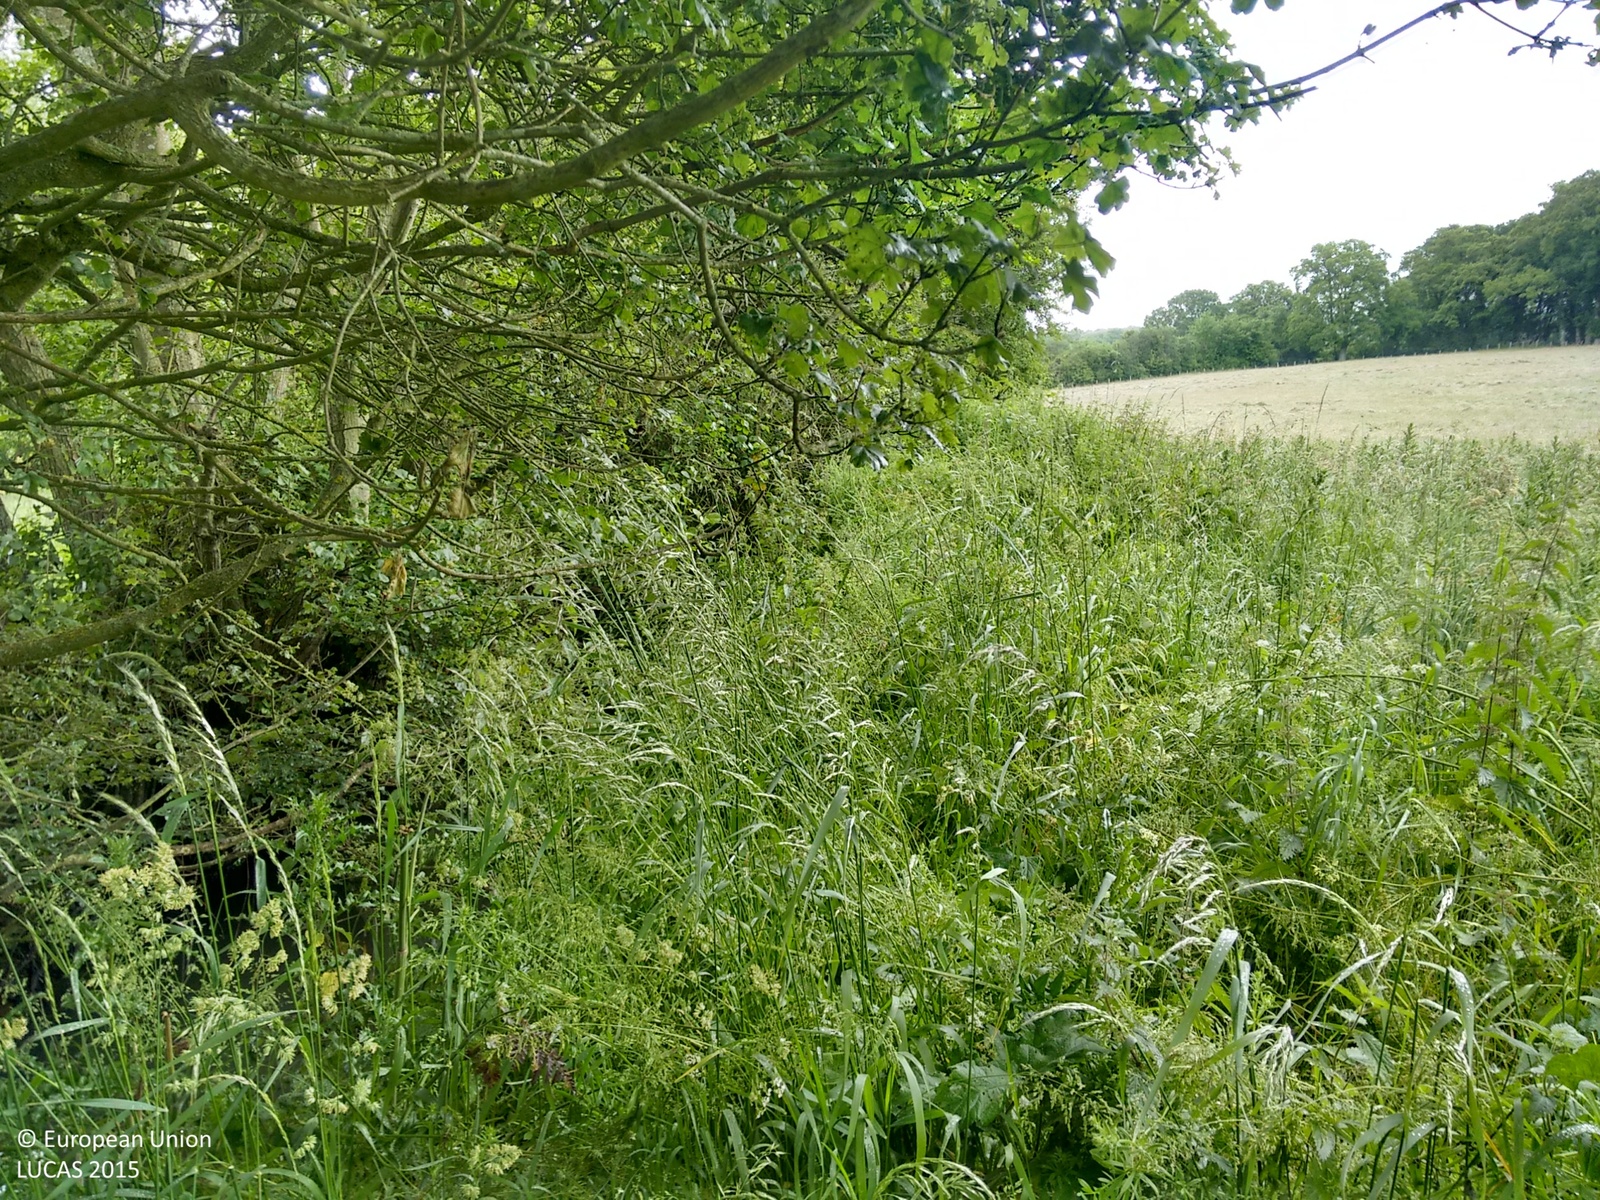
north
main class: Grassland
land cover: Grassland without tree/shrub cover
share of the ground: > 75 %
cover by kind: herbaceous plants 100 %
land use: Agriculture (excluding fallow land and kitchen gardens)
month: June
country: GB
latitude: 51.0235
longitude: 0.3473
